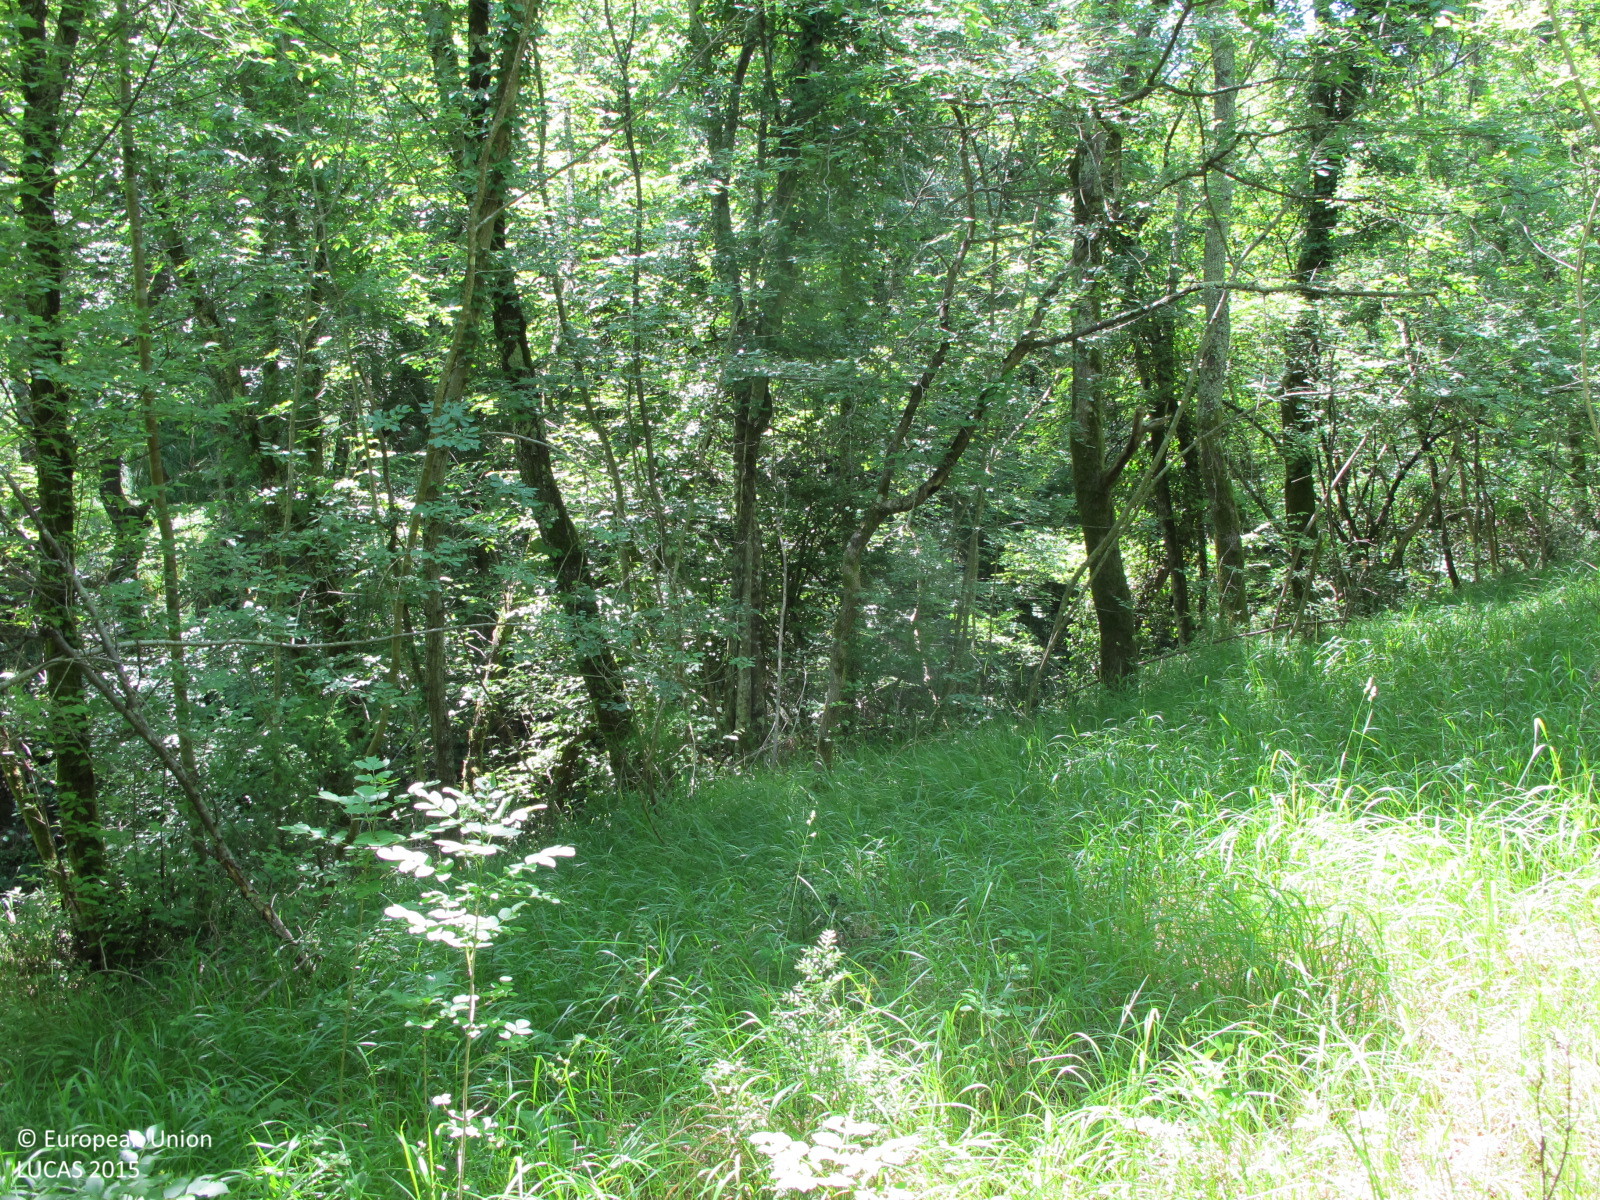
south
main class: Woodland
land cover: Broadleaved woodland
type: thermophilous deciduous forest
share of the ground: > 75 %
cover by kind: broadleaved forest trees 75 %, shrubs 10 %, herbaceous plants 10 %, consolidated bare surface 5 %
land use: Forestry
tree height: > 5 m
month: May
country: HR
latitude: 45.1850
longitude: 14.2327
